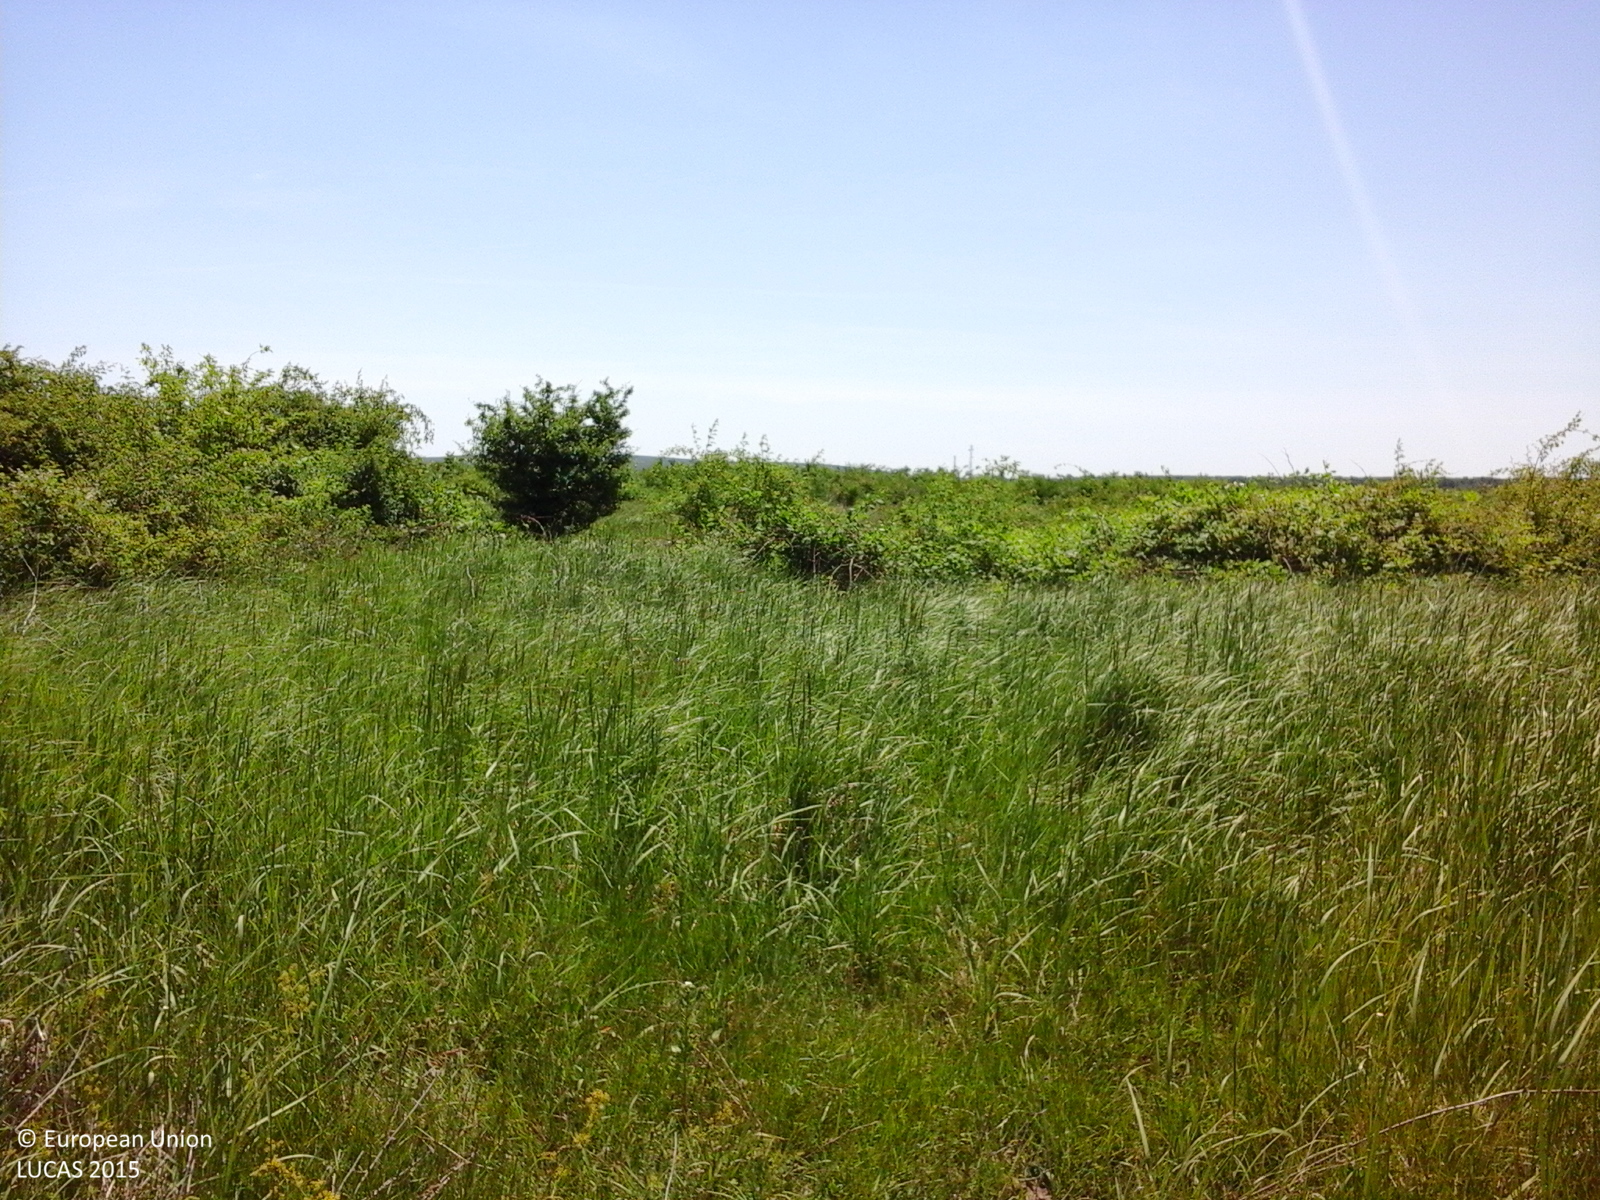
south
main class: Grassland
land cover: Grassland with sparse tree/shrub cover
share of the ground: > 75 %
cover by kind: herbaceous plants 85 %, shrubs 10 %, broadleaved forest trees 5 %
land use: Agriculture (excluding fallow land and kitchen gardens)
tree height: < 5 m
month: June
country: RO
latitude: 44.9302
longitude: 25.6718
